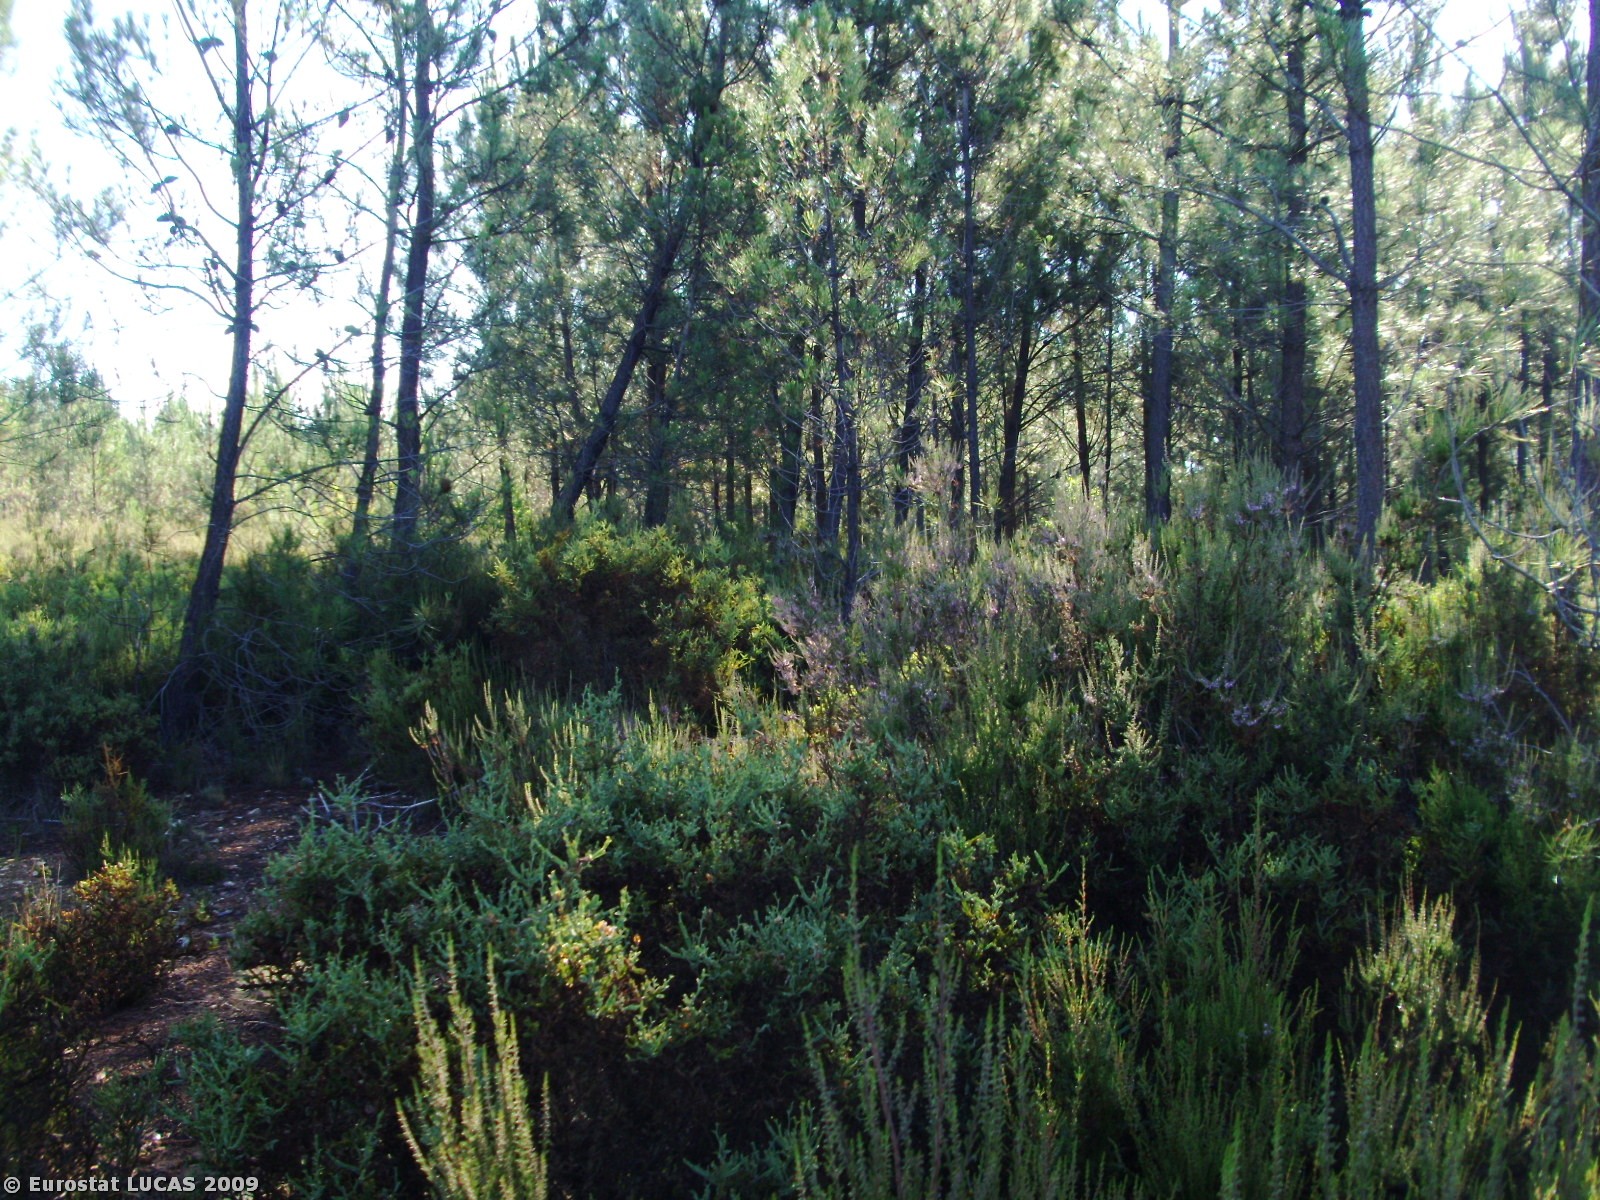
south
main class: Woodland
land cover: Coniferous woodland
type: coniferous forest of the mediterranean region
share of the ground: > 75 %
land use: Forestry
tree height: > 5 m
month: July
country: PT
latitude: 40.2256
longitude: -7.6318
